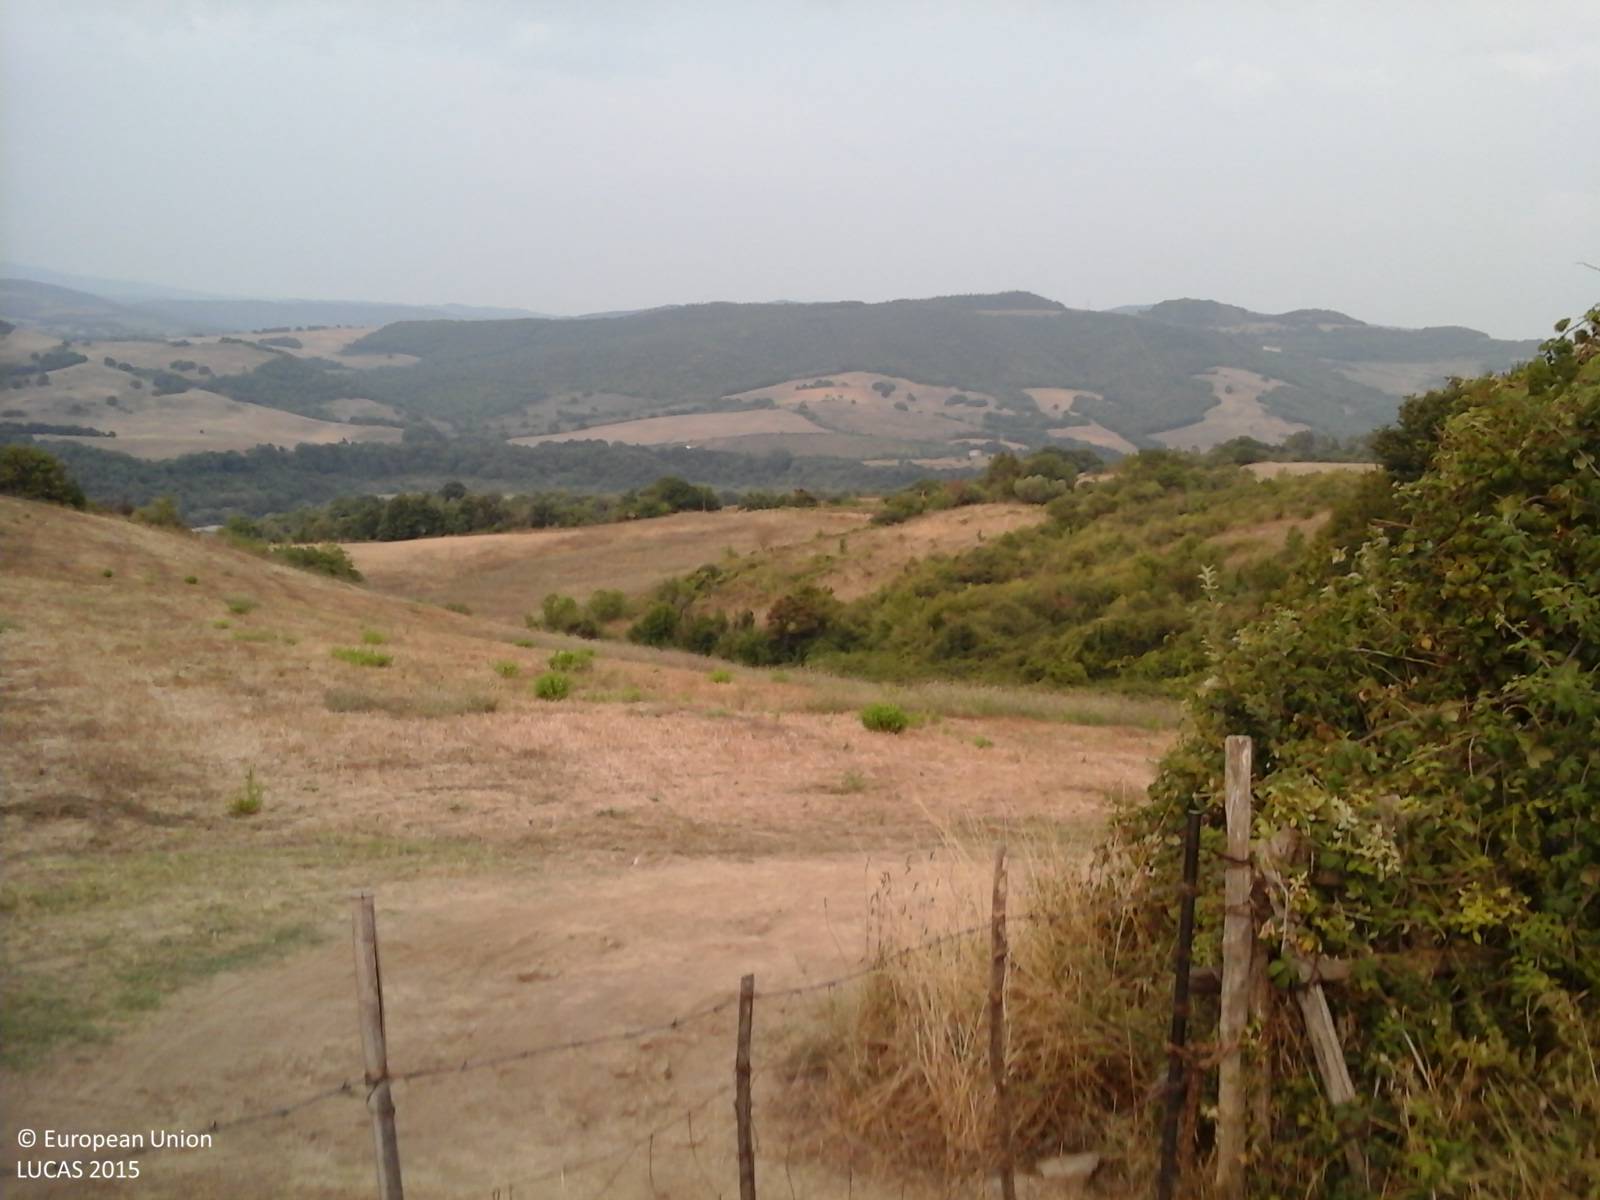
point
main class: Cropland
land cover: Vineyards
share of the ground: 25 - 50 %
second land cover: Grassland without tree/shrub cover
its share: > 75 %
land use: Abandoned areas
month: August
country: IT
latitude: 42.2013
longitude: 11.9670
